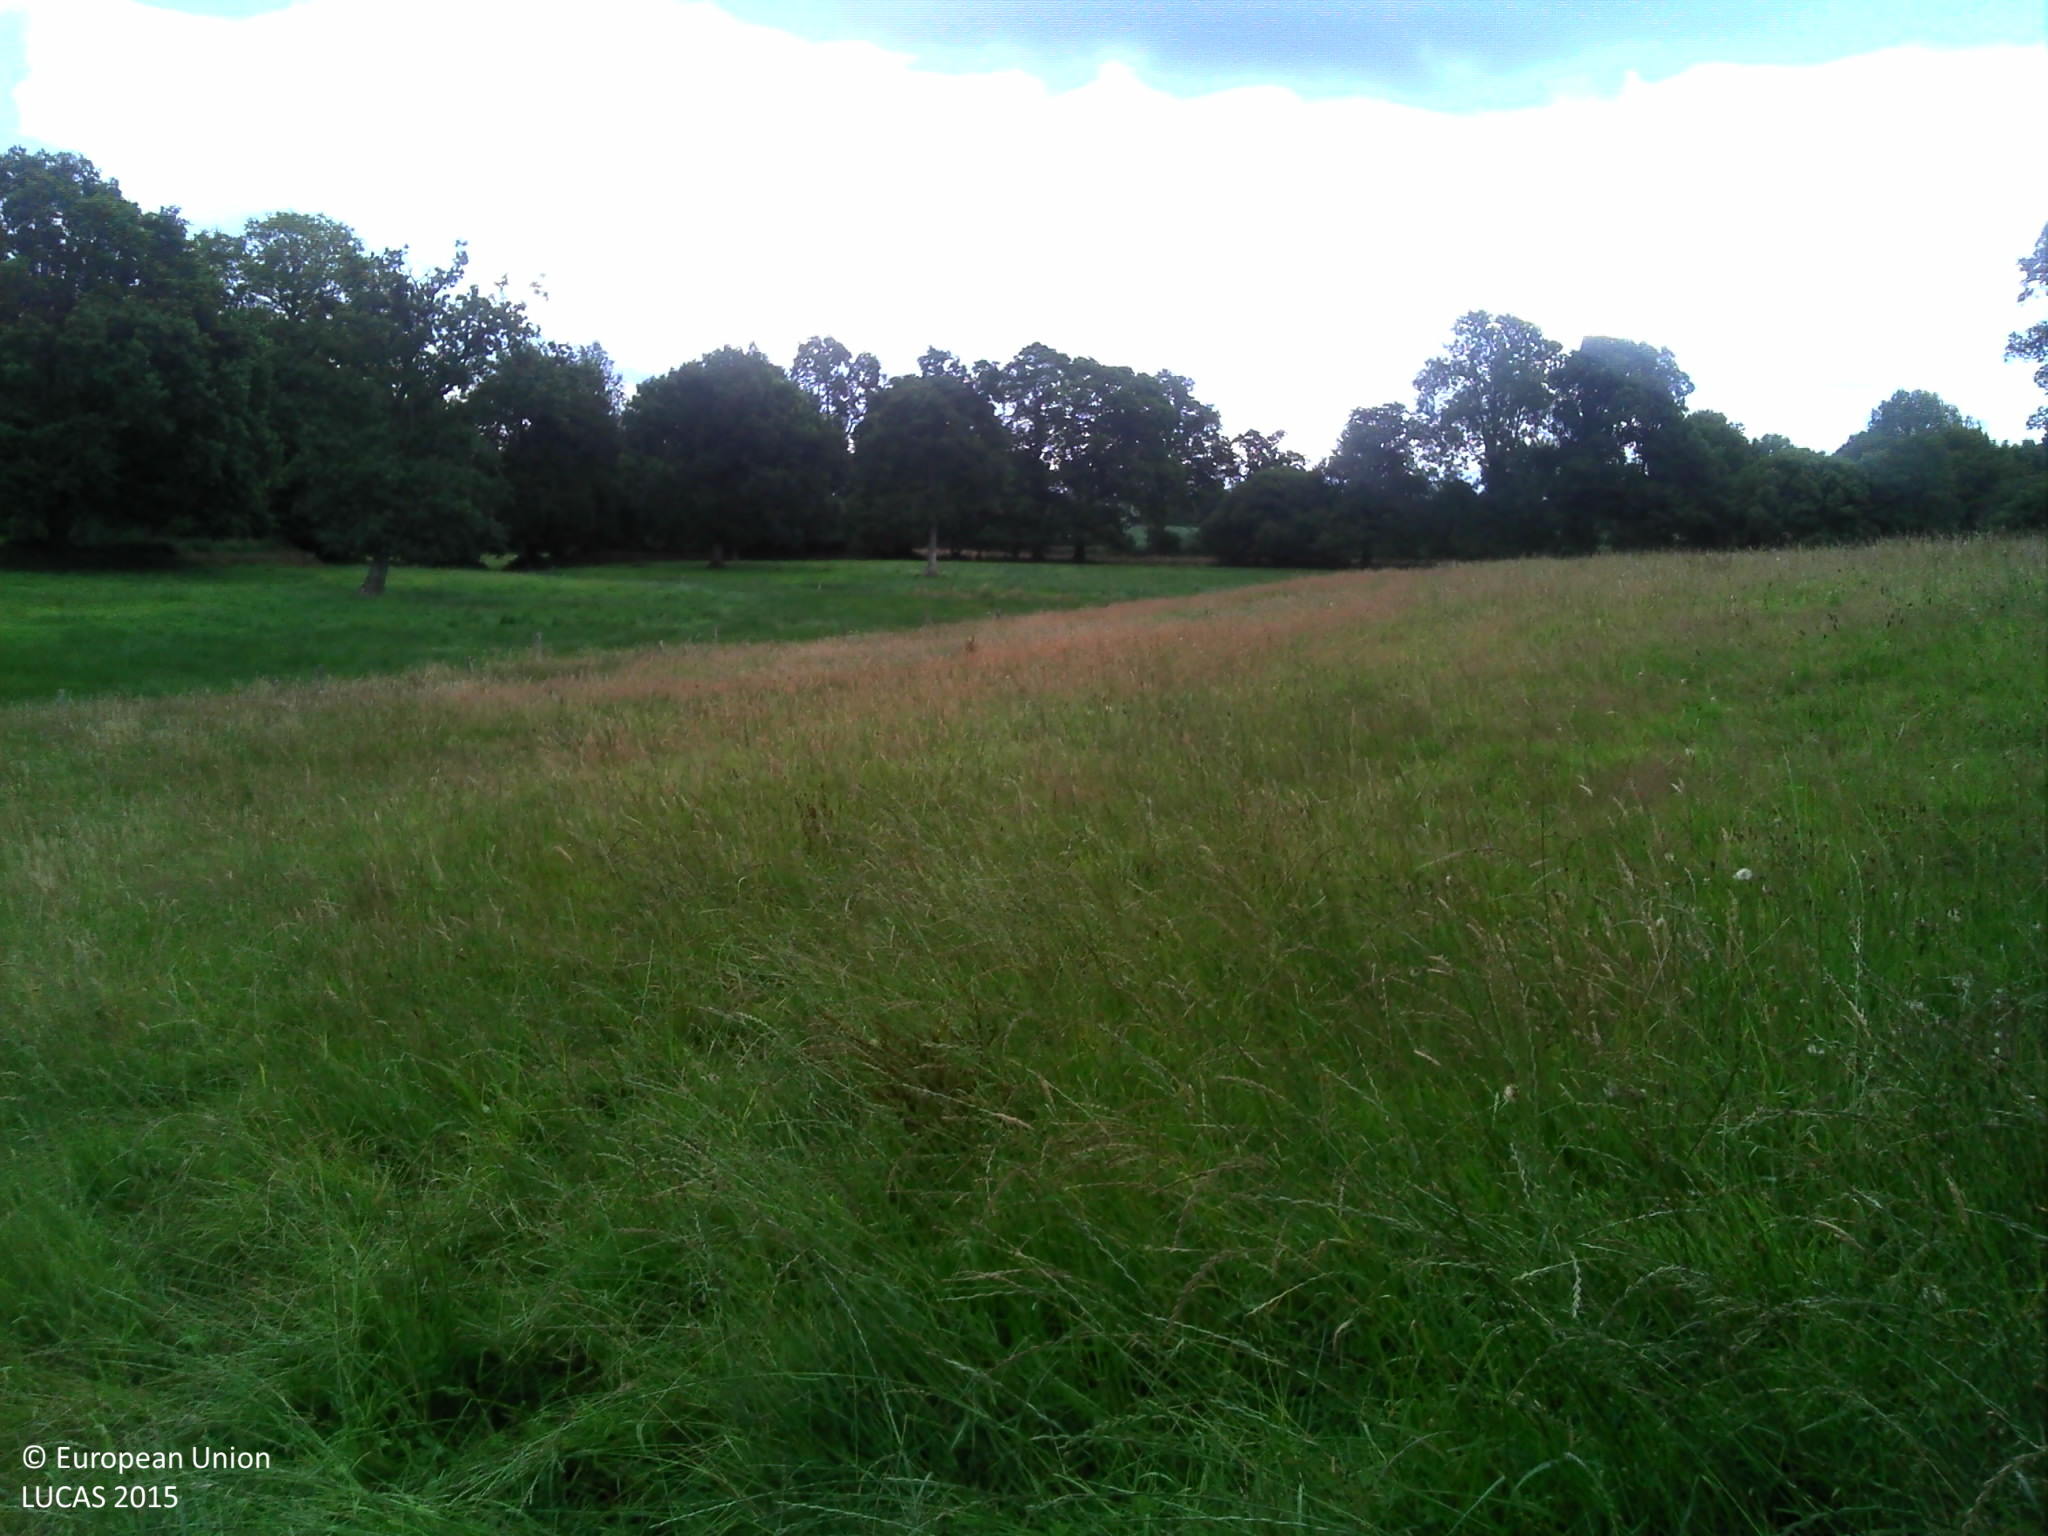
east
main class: Grassland
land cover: Grassland without tree/shrub cover
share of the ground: > 75 %
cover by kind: herbaceous plants 100 %
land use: Agriculture (excluding fallow land and kitchen gardens)
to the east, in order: Grassland without tree/shrub cover; Fences; Rivers and streams; Fences; Grassland without tree/shrub cover; Fences; Rivers and streams; Fences; Grassland without tree/shrub cover; Broadleaved woodland; Grassland without tree/shrub cover; Managed hedges; Maize
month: July
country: FR
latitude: 48.7849
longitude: -1.3009
